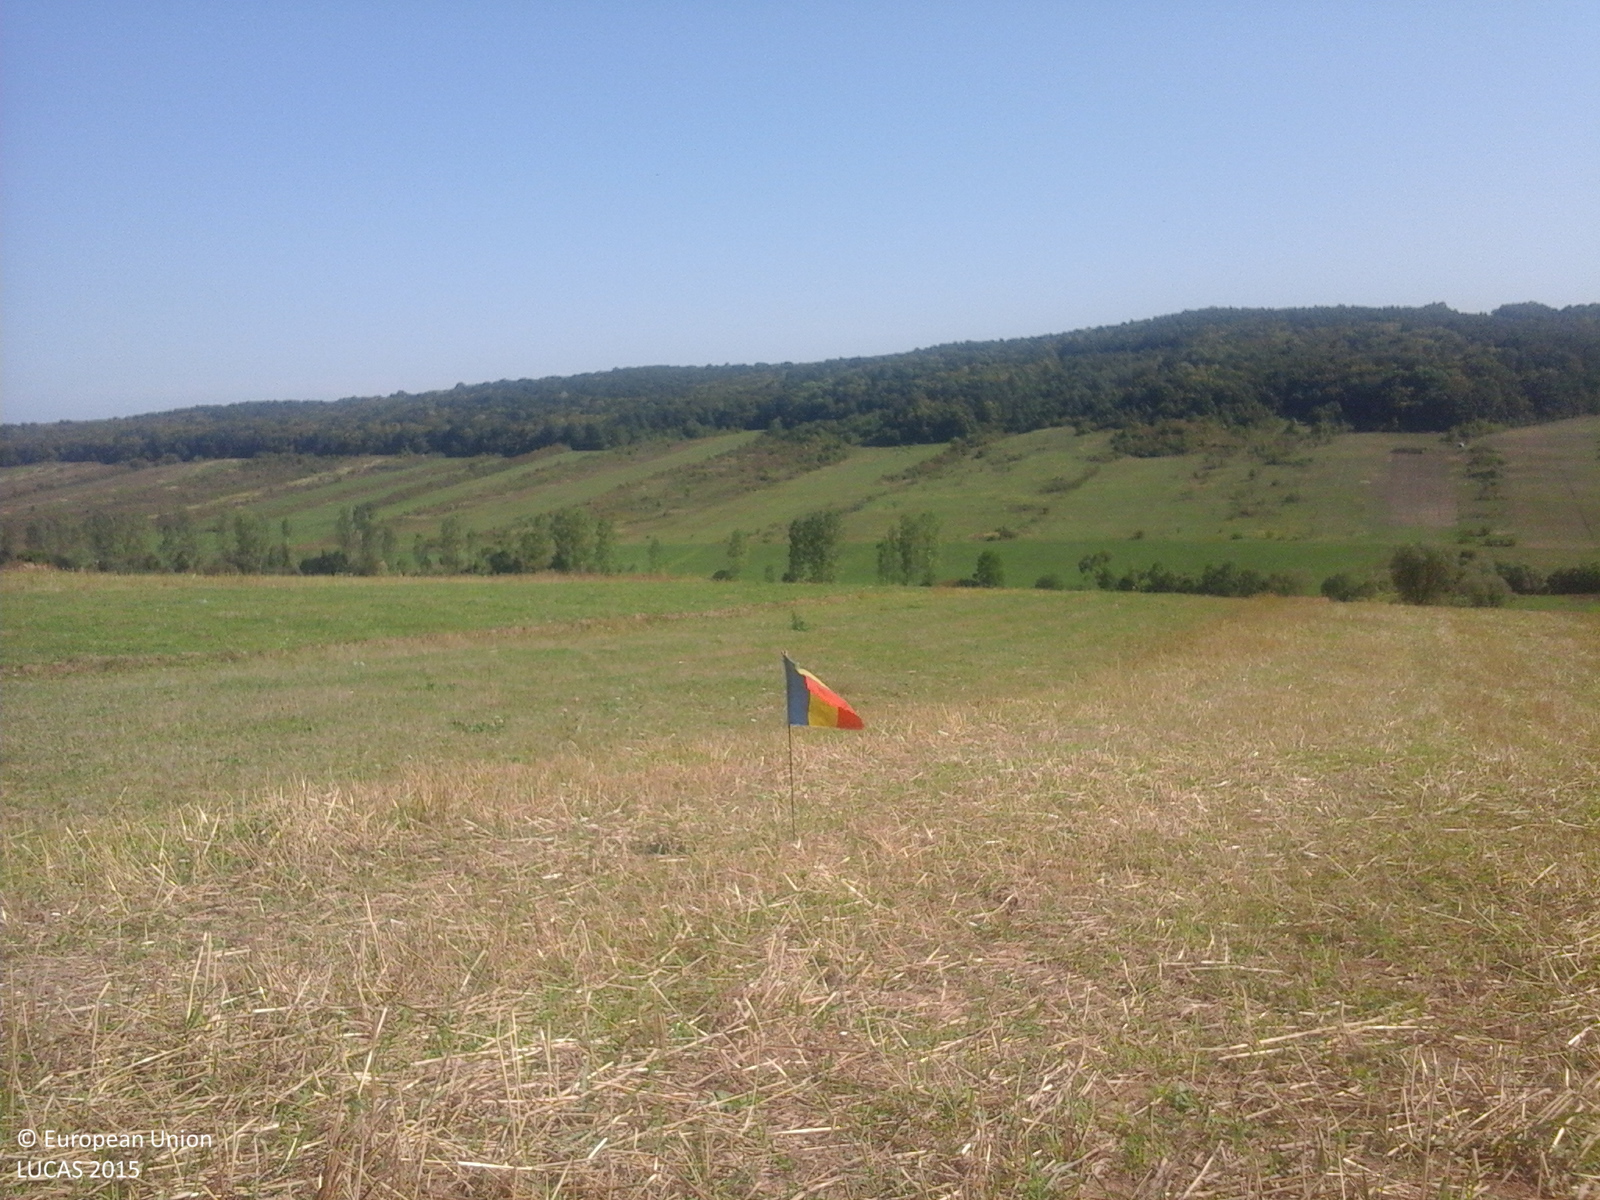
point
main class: Cropland
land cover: Common wheat
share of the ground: < 10 %
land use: Agriculture (excluding fallow land and kitchen gardens)
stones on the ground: < 10 %
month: September
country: RO
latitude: 47.1621
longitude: 22.8158
